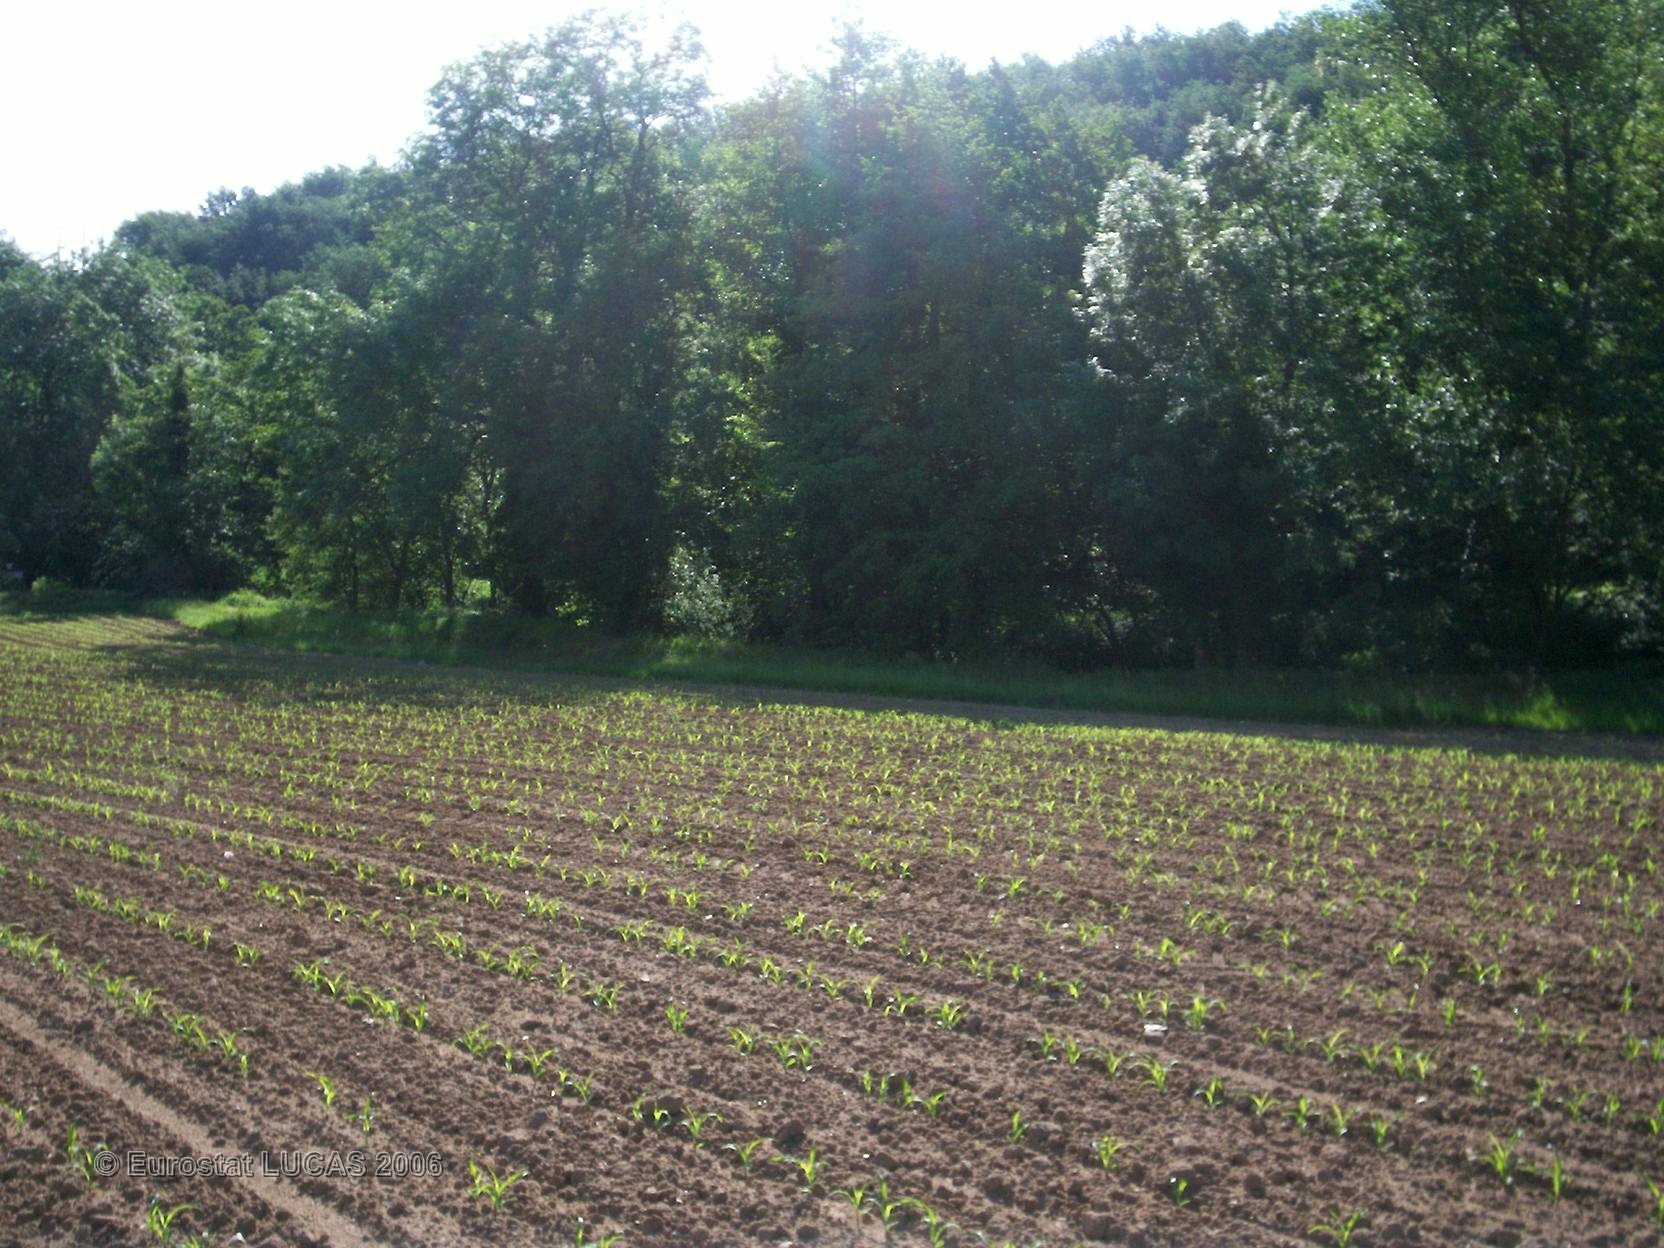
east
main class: Cropland
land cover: Maize
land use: Agriculture (excluding fallow land and kitchen gardens)
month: May
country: FR
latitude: 45.6090
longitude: 4.7595
